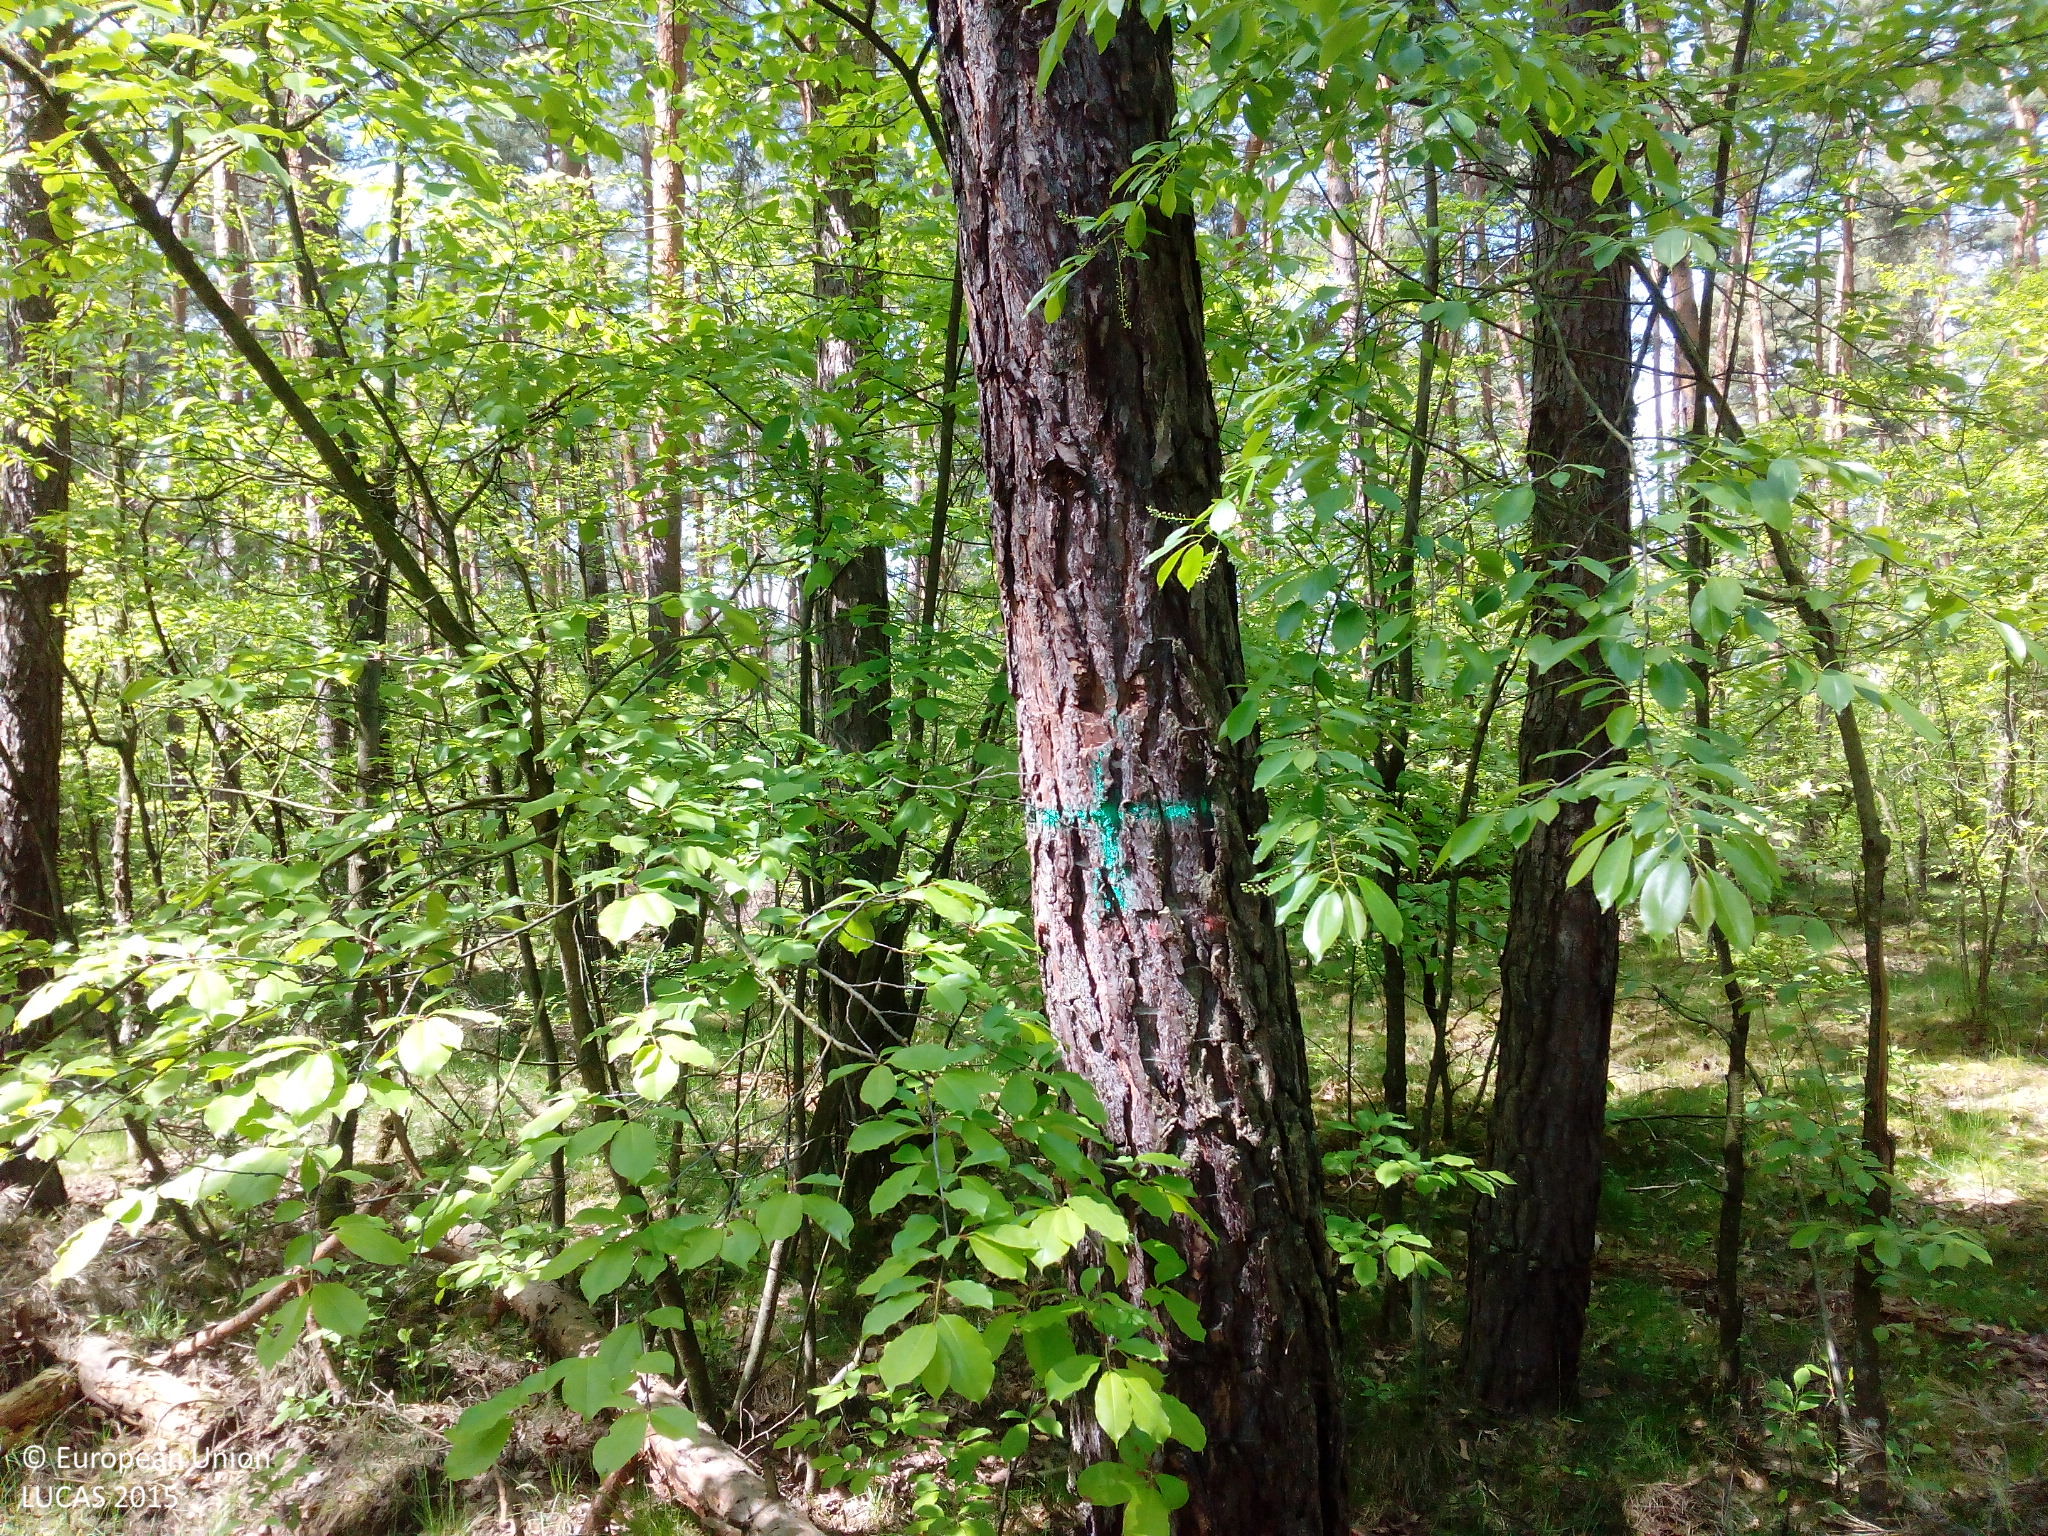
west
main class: Woodland
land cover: Pine dominated mixed woodland
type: hemiboreal forest and nemoral coniferous forest and mixed broadleaved-coniferous forest
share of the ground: 50 - 75 %
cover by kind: coniferous forest trees 40 %, broadleaved forest trees 25 %, herbaceous plants 20 %, unconsolidated bare surface 10 %, shrubs 5 %
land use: Forestry
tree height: > 5 m
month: May
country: DE
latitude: 49.5811
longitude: 8.5205
